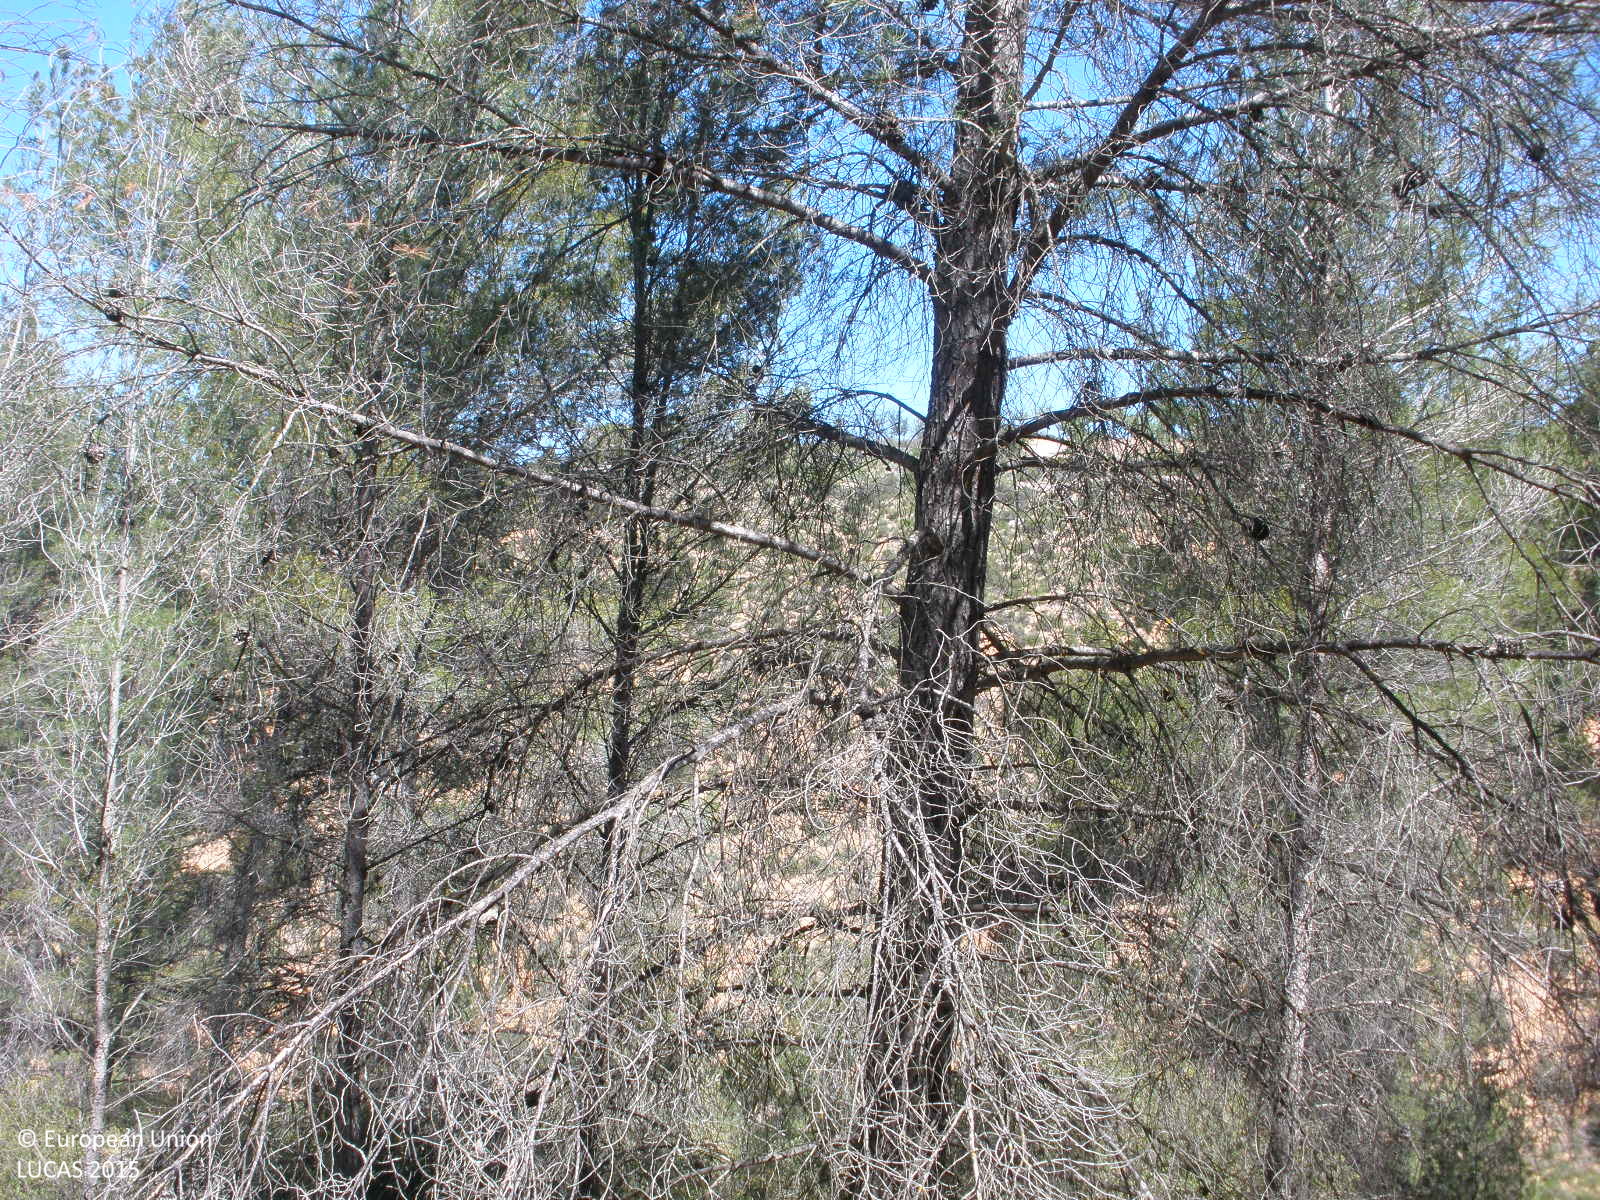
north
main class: Woodland
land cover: Pine dominated coniferous woodland
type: coniferous forest of the mediterranean region
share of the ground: 25 - 50 %
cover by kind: shrubs 60 %, coniferous forest trees 40 %
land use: Semi-natural and natural areas not in use
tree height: > 5 m
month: April
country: ES
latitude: 40.1302
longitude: -1.2402
